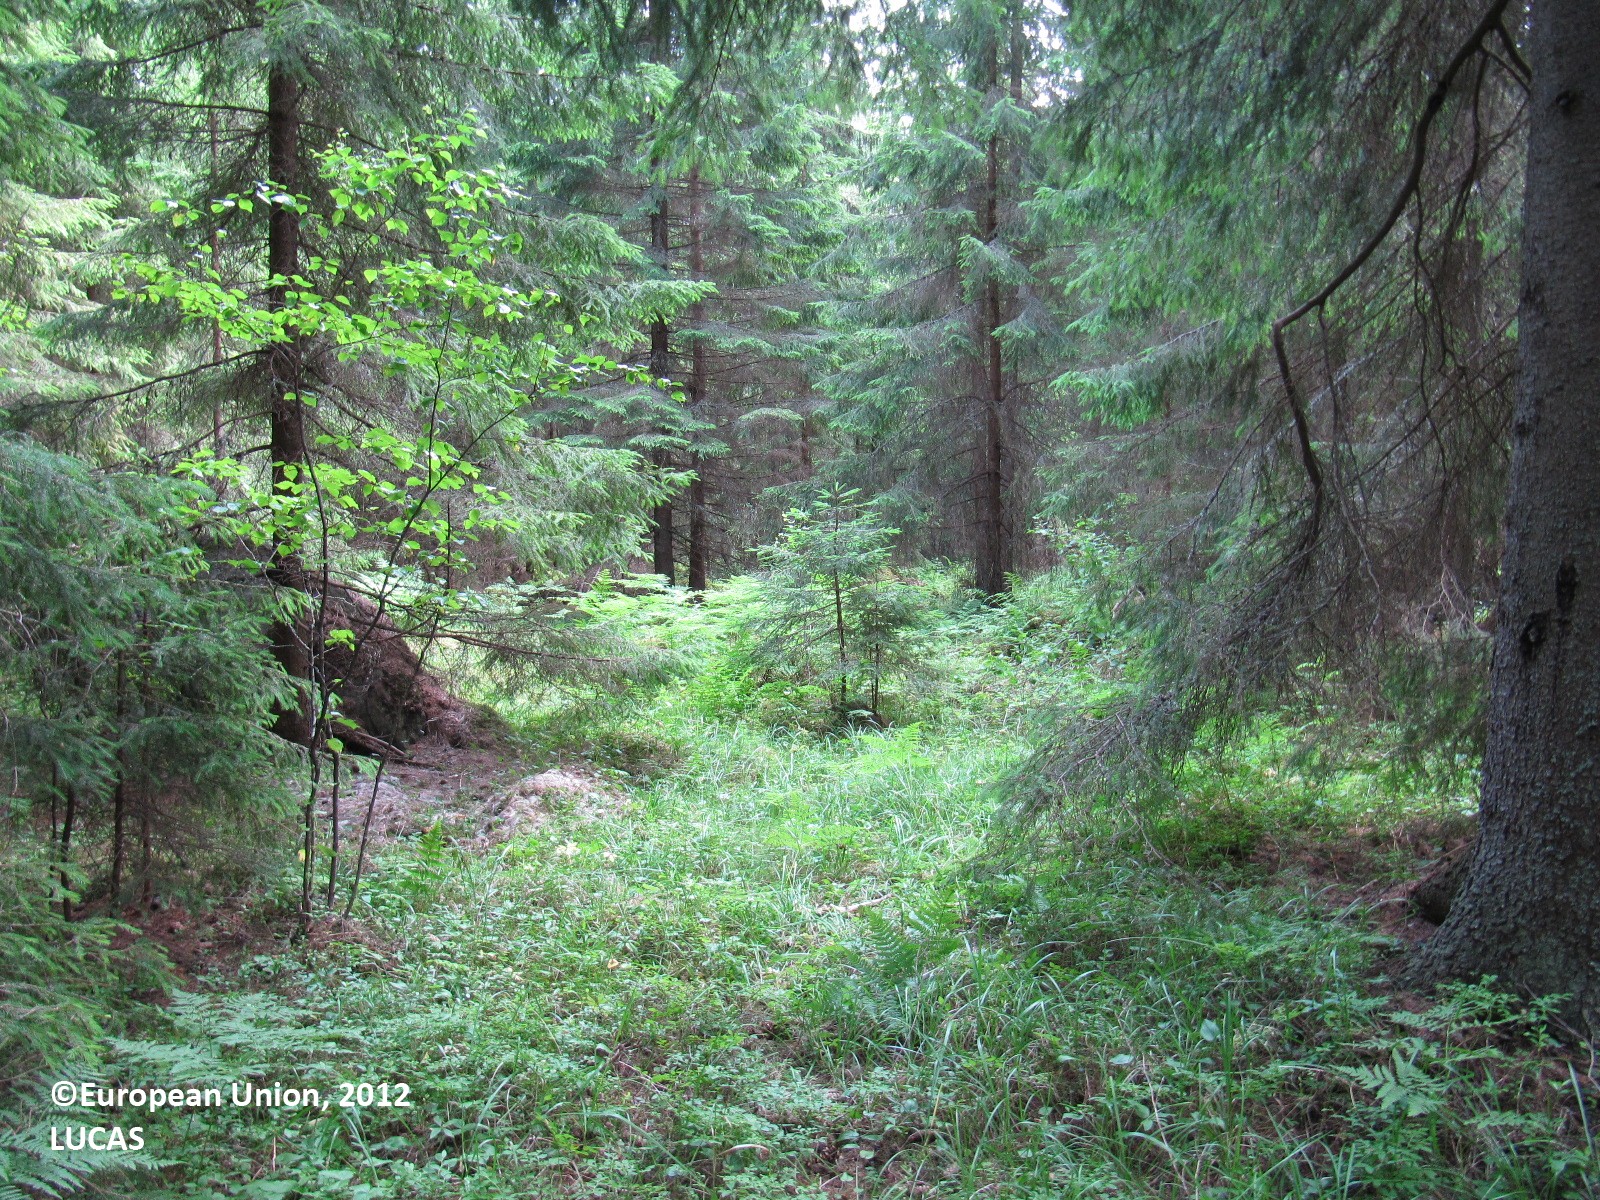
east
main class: Woodland
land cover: Spruce dominated coniferous woodland
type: boreal forest
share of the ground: > 75 %
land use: Forestry
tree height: > 5 m
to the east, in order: Spruce dominated coniferous woodland; Grassland with sparse tree/shrub cover; Spruce dominated mixed woodland
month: July
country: FI
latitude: 61.0149
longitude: 23.4574
